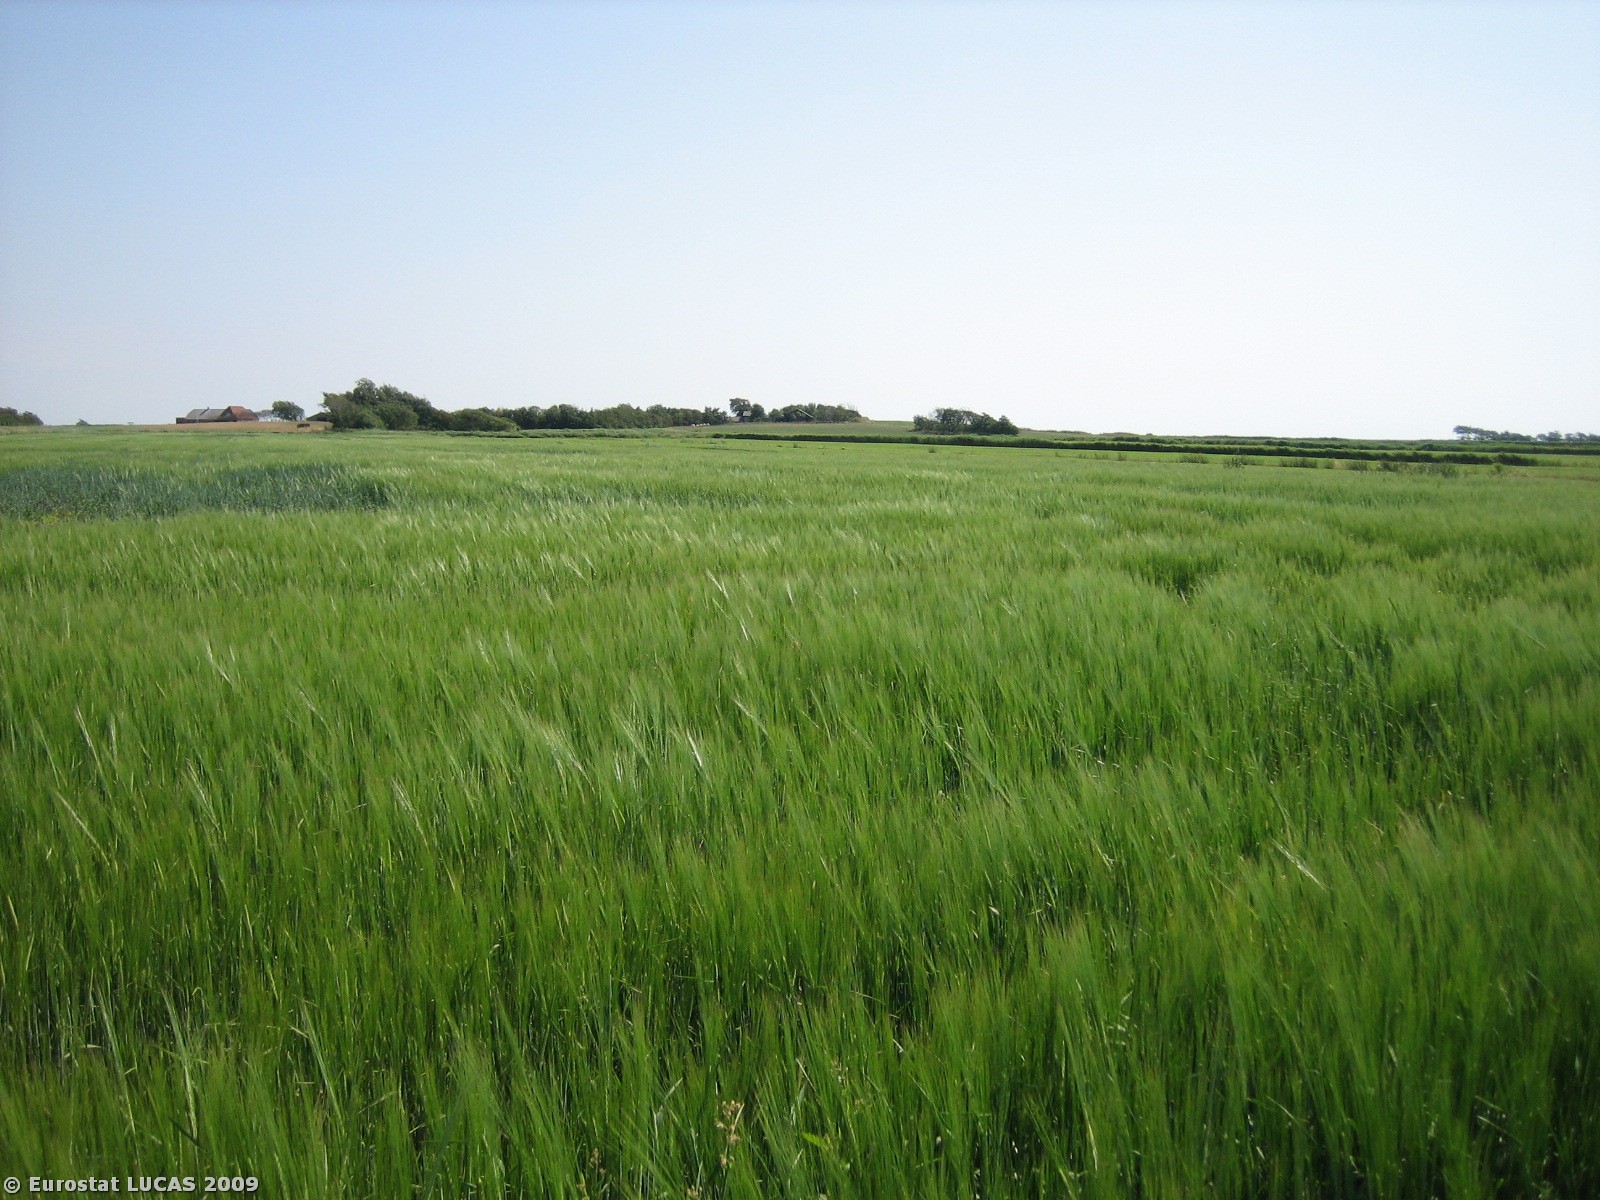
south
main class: Cropland
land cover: Barley
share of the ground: > 75 %
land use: Agriculture (excluding fallow land and kitchen gardens)
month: July
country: DK
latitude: 55.4077
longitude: 8.6587
